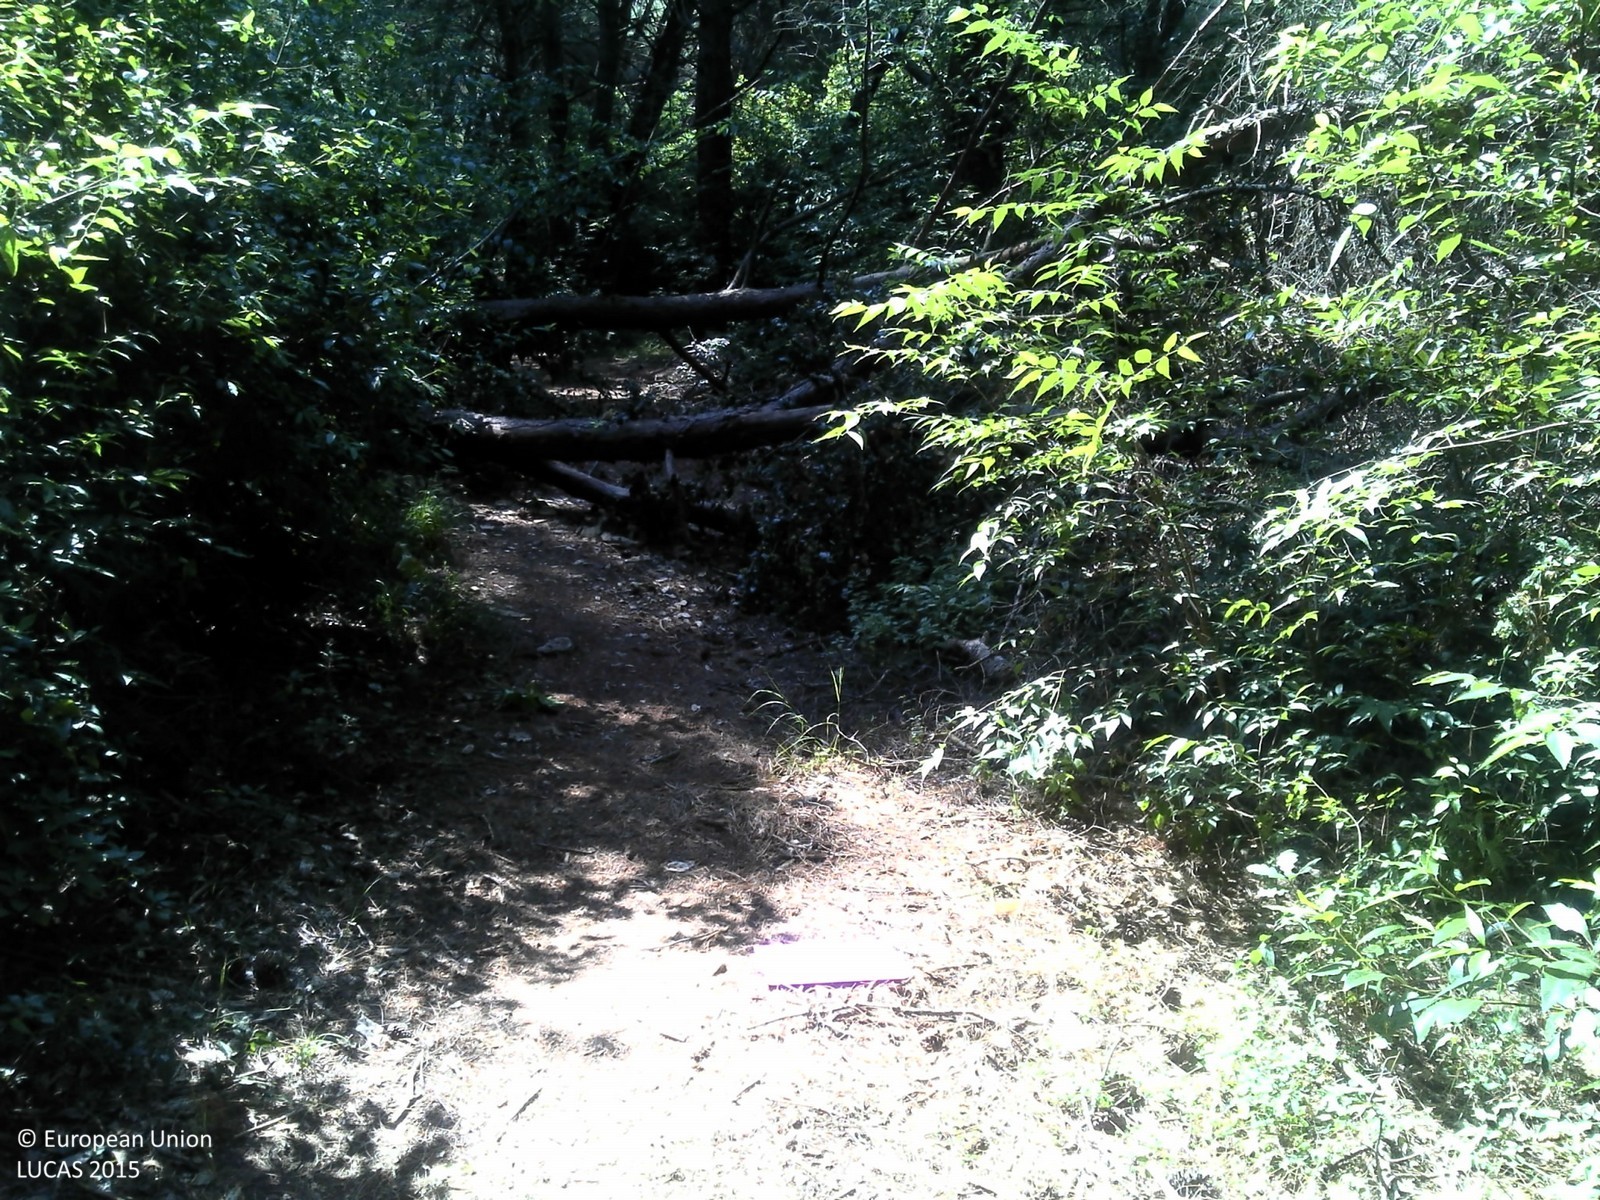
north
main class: Woodland
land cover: Other coniferous woodland
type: coniferous forest of the mediterranean region
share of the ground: > 75 %
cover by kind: coniferous forest trees 85 %, shrubs 10 %, broadleaved forest trees 5 %
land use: Sport
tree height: > 5 m
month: June
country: HR
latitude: 44.8576
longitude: 13.8284
